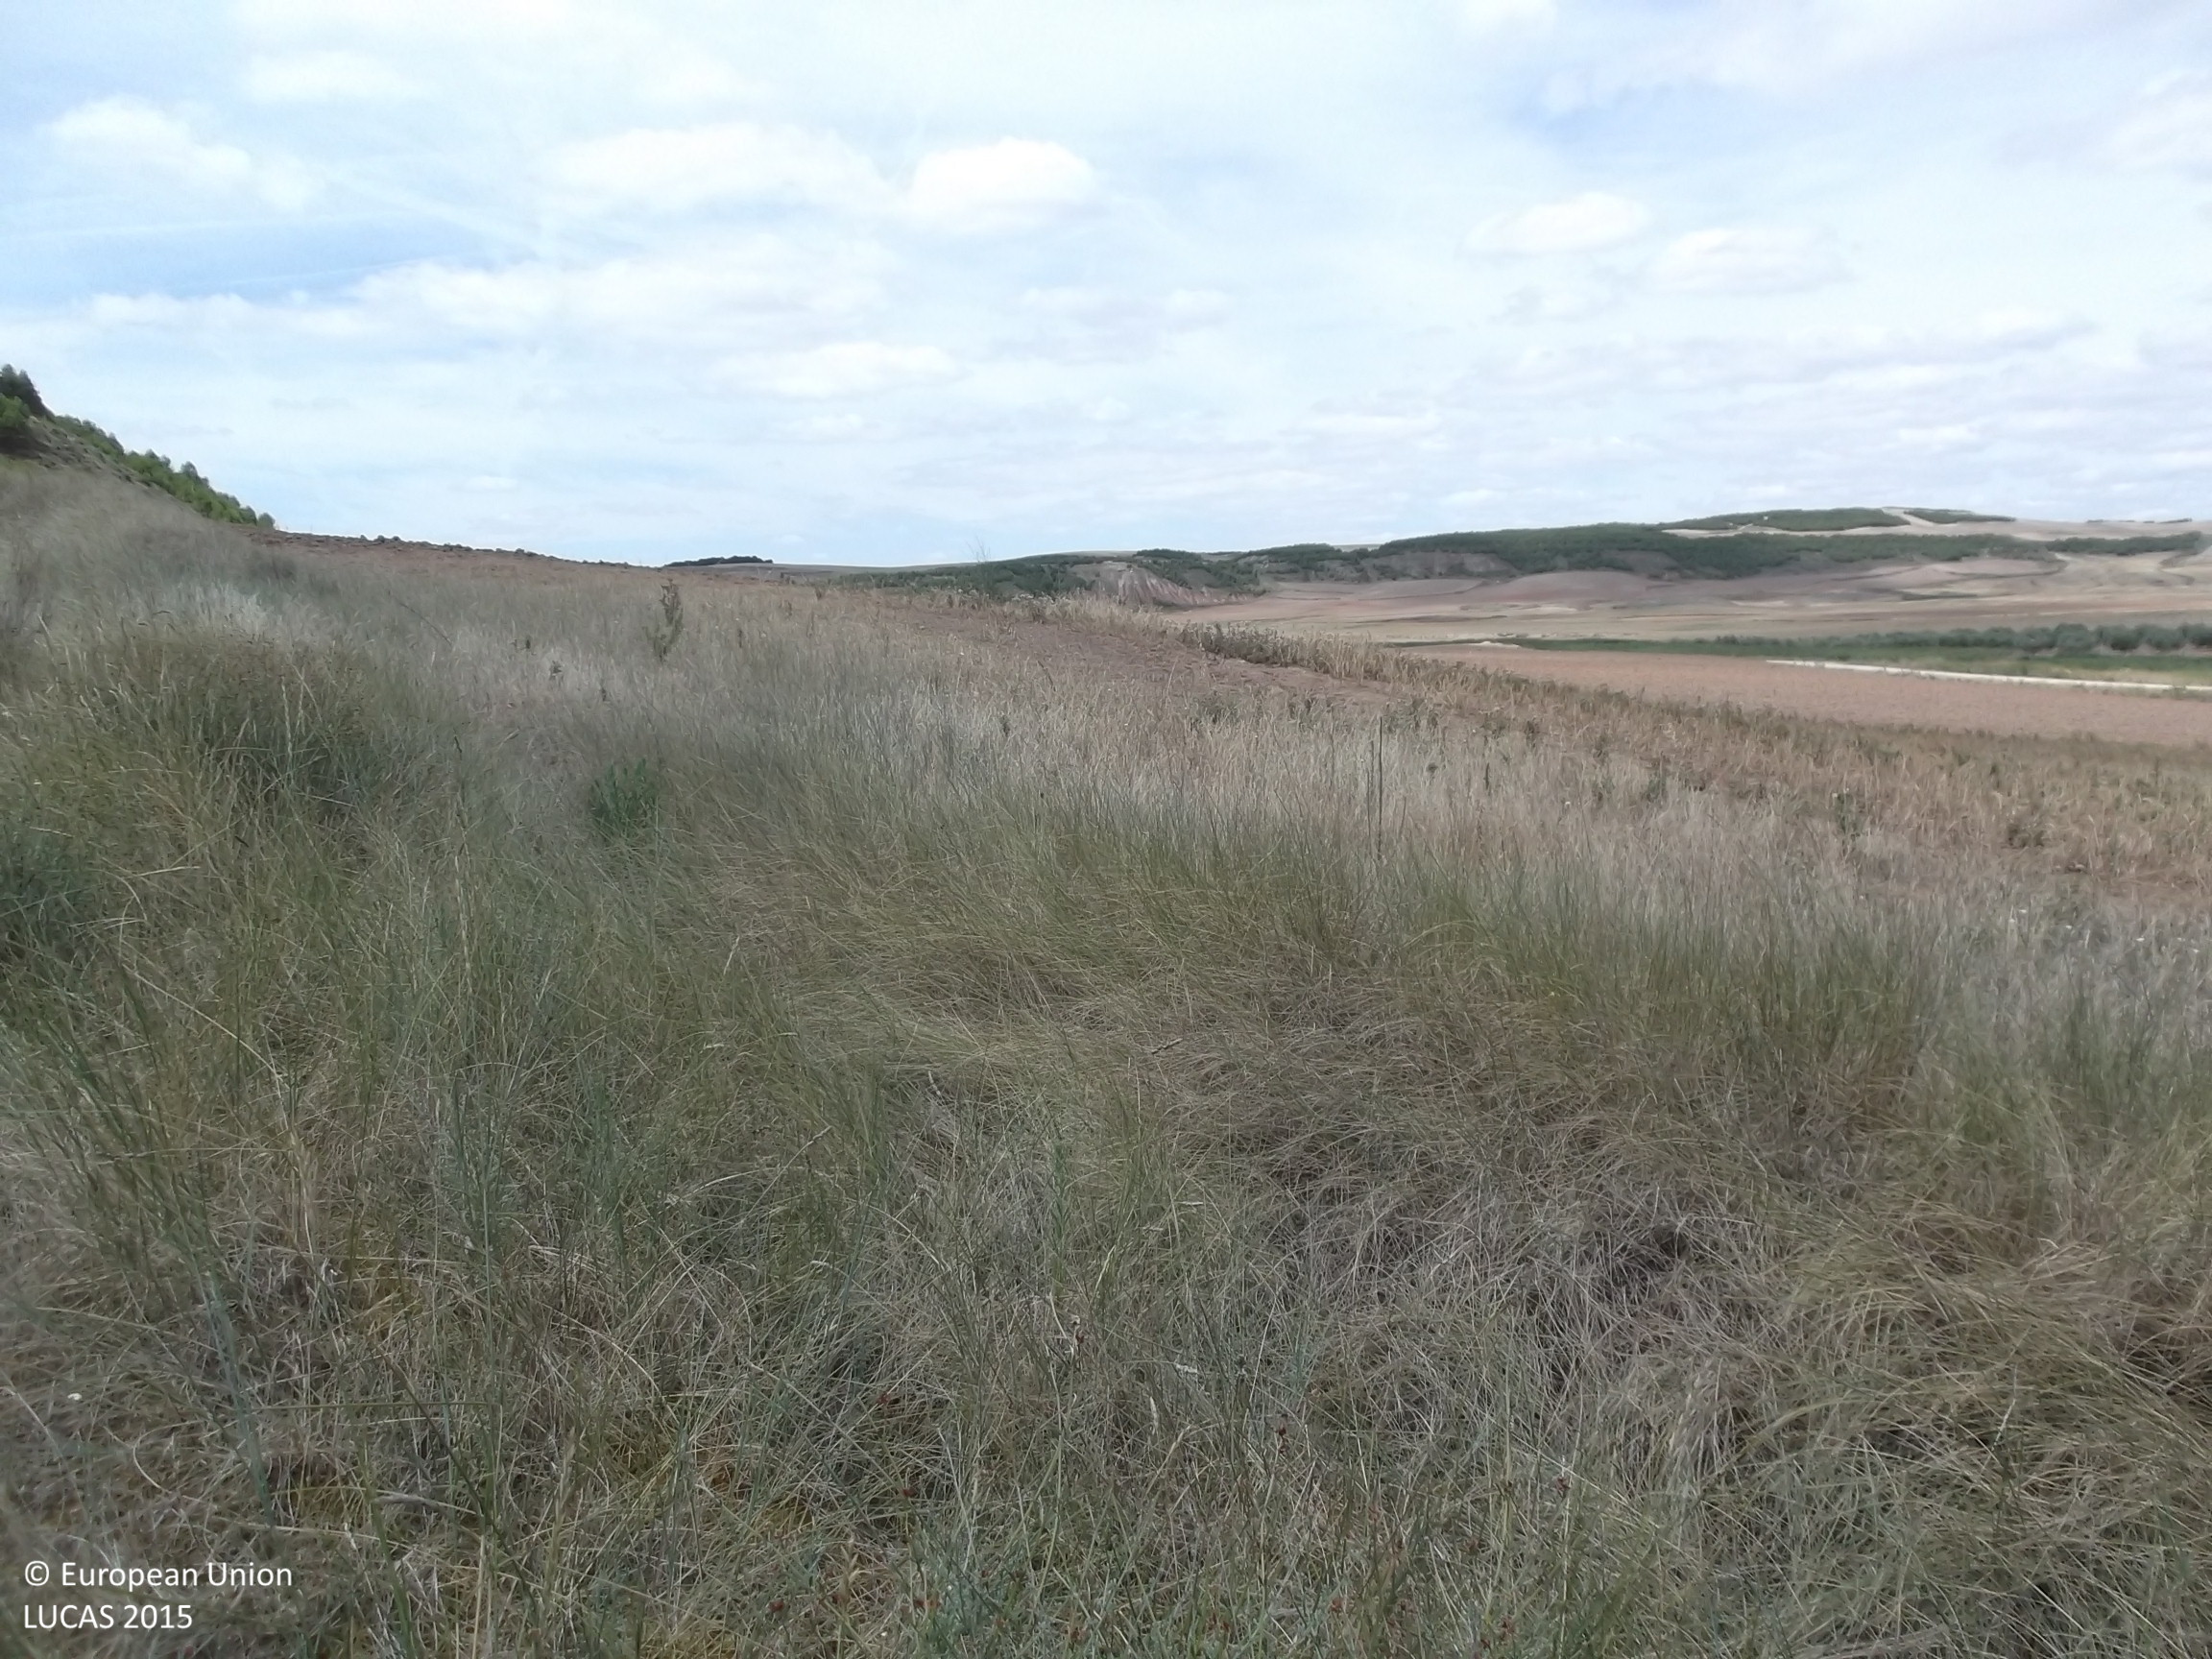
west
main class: Grassland
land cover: Grassland with sparse tree/shrub cover
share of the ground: > 75 %
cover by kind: herbaceous plants 70 %, lichens and mosses 10 %, unconsolidated bare surface 10 %, coniferous forest trees 5 %, shrubs 5 %
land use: Semi-natural and natural areas not in use
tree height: < 5 m
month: August
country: ES
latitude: 42.4827
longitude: -2.1704
